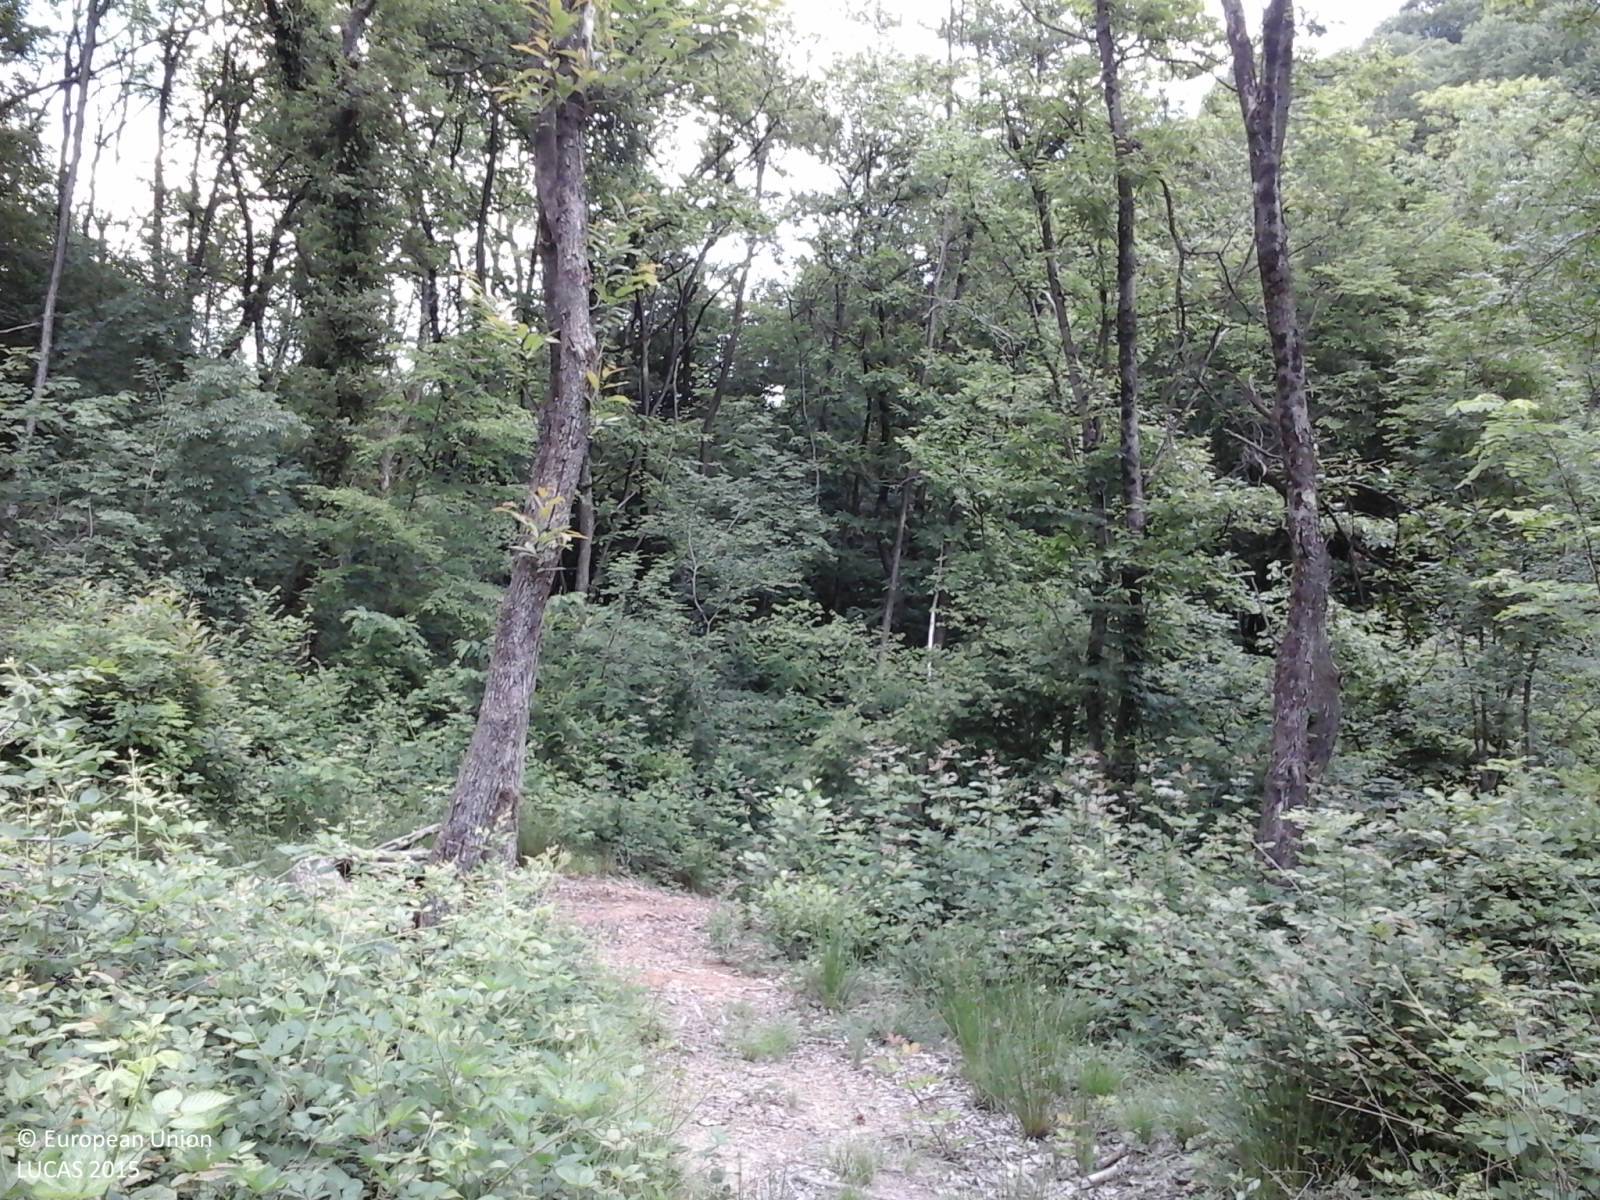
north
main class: Woodland
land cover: Broadleaved woodland
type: mesophytic deciduous forest
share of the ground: > 75 %
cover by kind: broadleaved forest trees 85 %, shrubs 10 %, herbaceous plants 5 %
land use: Forestry
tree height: > 5 m
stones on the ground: 25 - 50 %
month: May
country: IT
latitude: 46.1749
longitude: 13.2737
